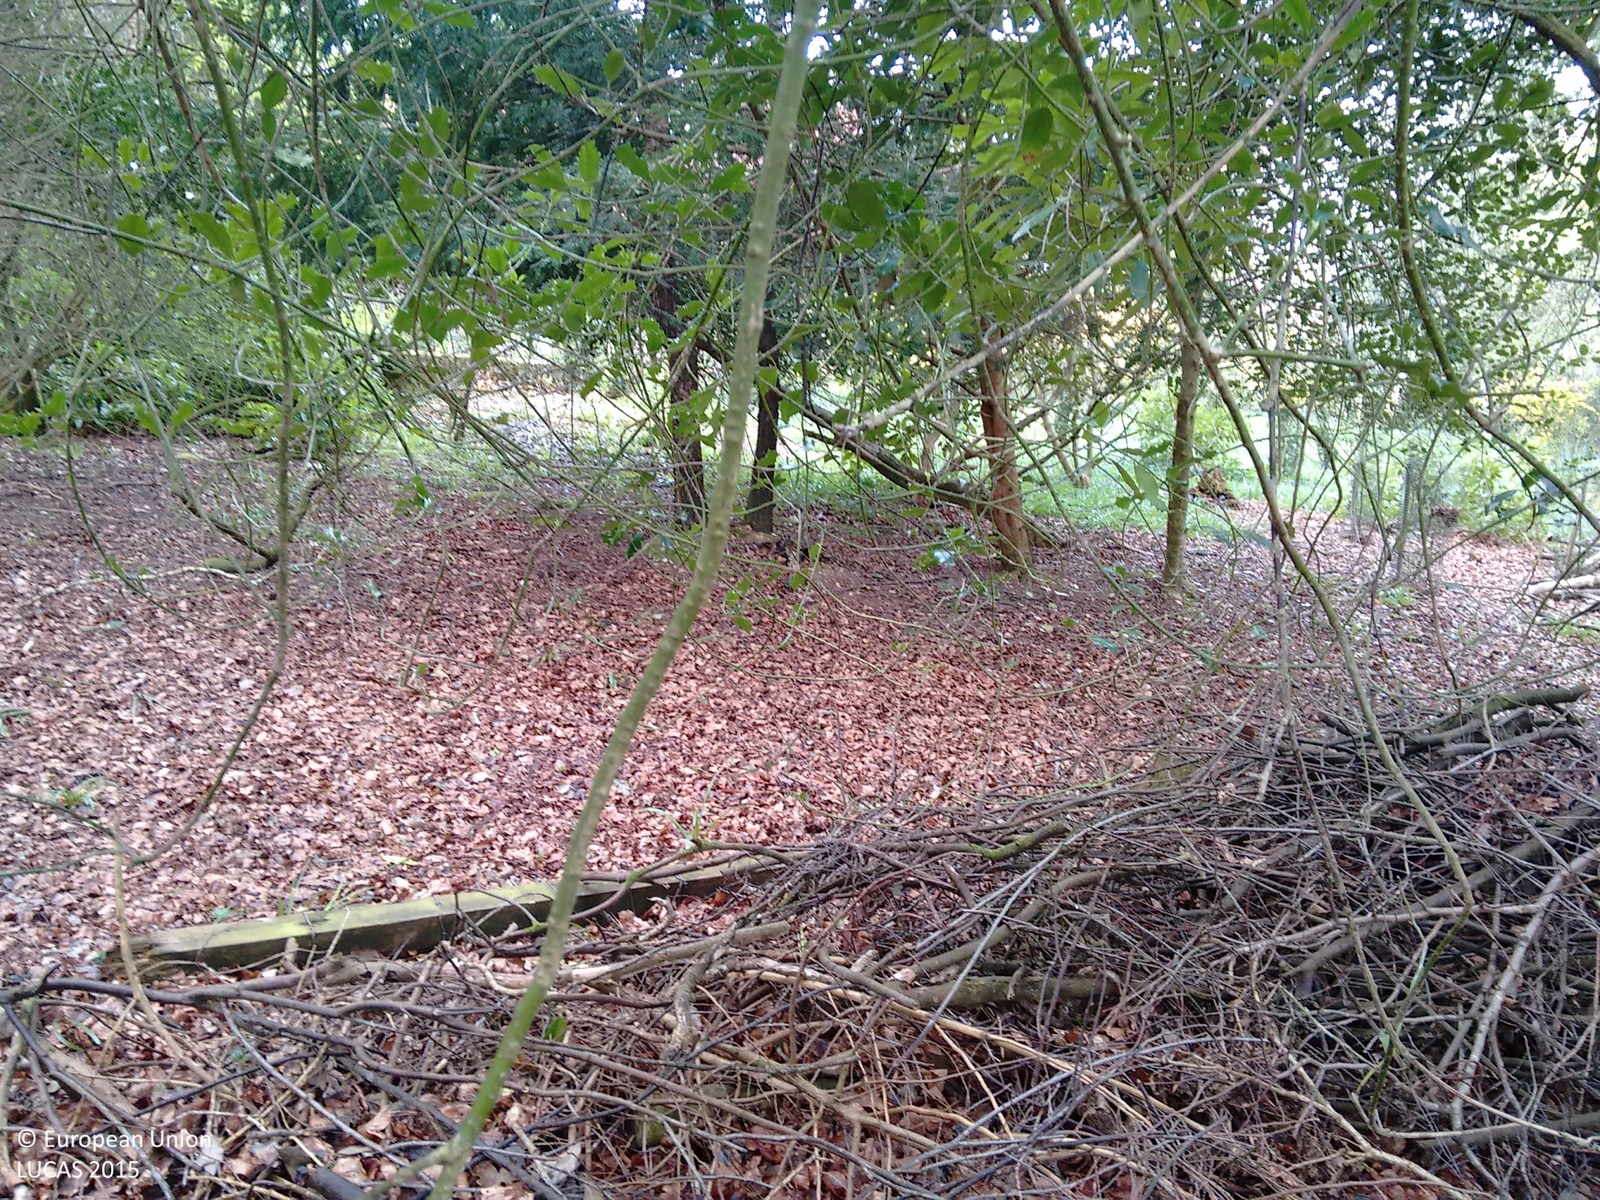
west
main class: Woodland
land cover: Broadleaved woodland
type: mesophytic deciduous forest
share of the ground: > 75 %
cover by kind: broadleaved forest trees 100 %
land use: Residential
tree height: > 5 m
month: April
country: GB
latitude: 50.9563
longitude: -1.7425
